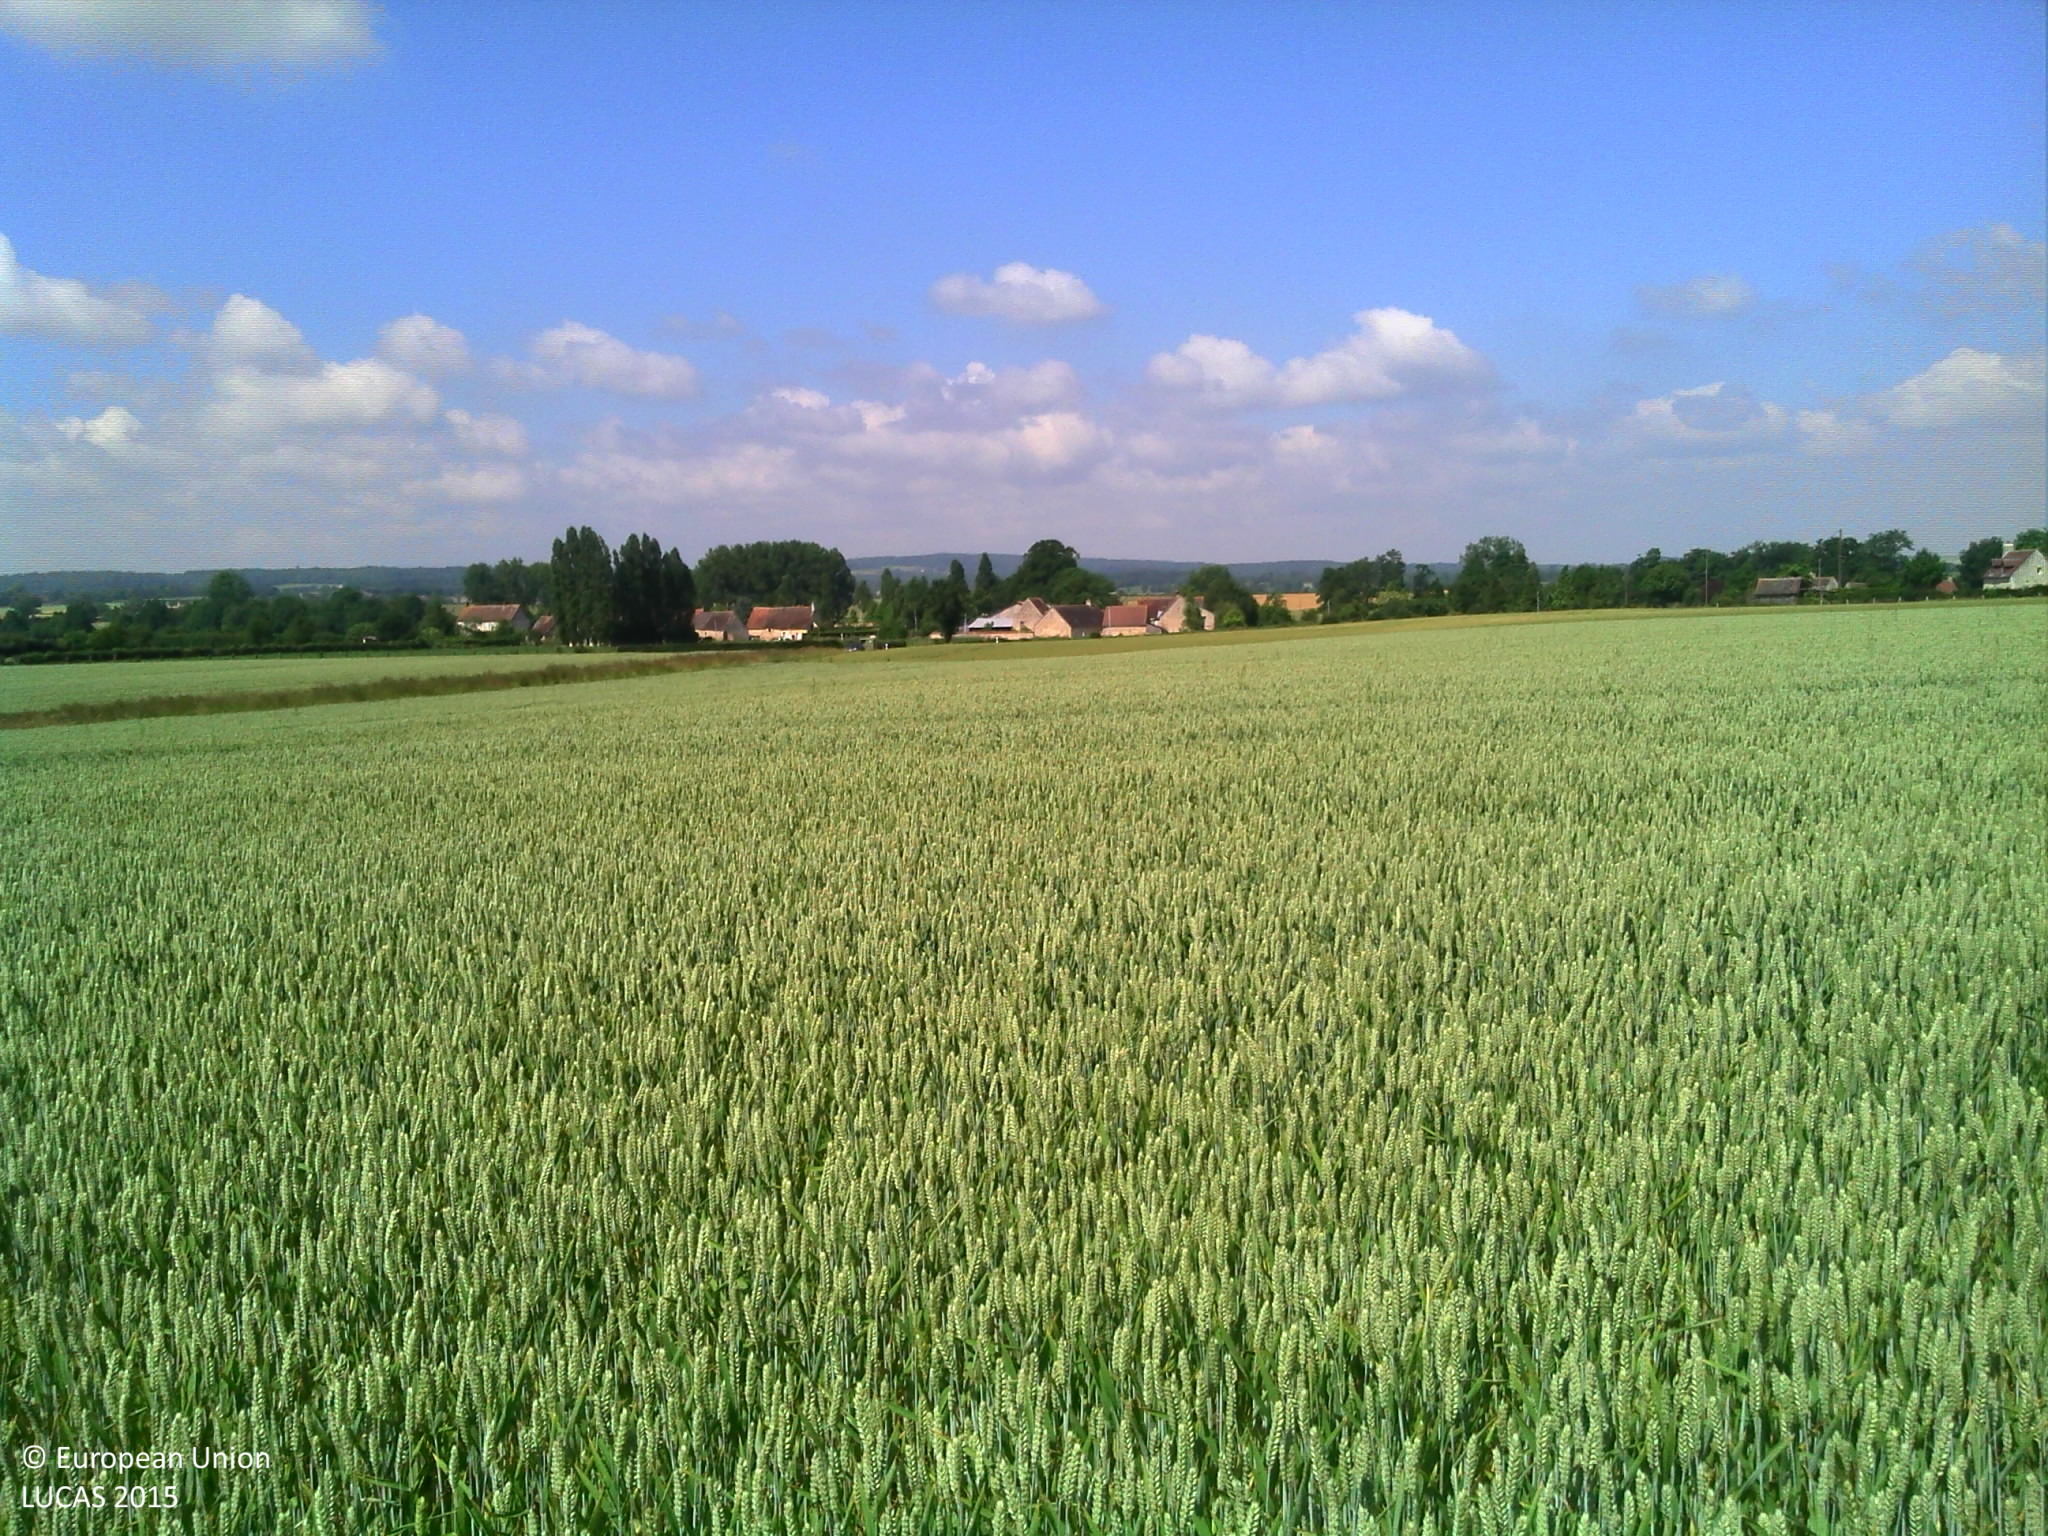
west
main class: Cropland
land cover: Common wheat
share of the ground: > 75 %
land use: Agriculture (excluding fallow land and kitchen gardens)
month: June
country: FR
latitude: 48.6294
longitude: 0.1070
